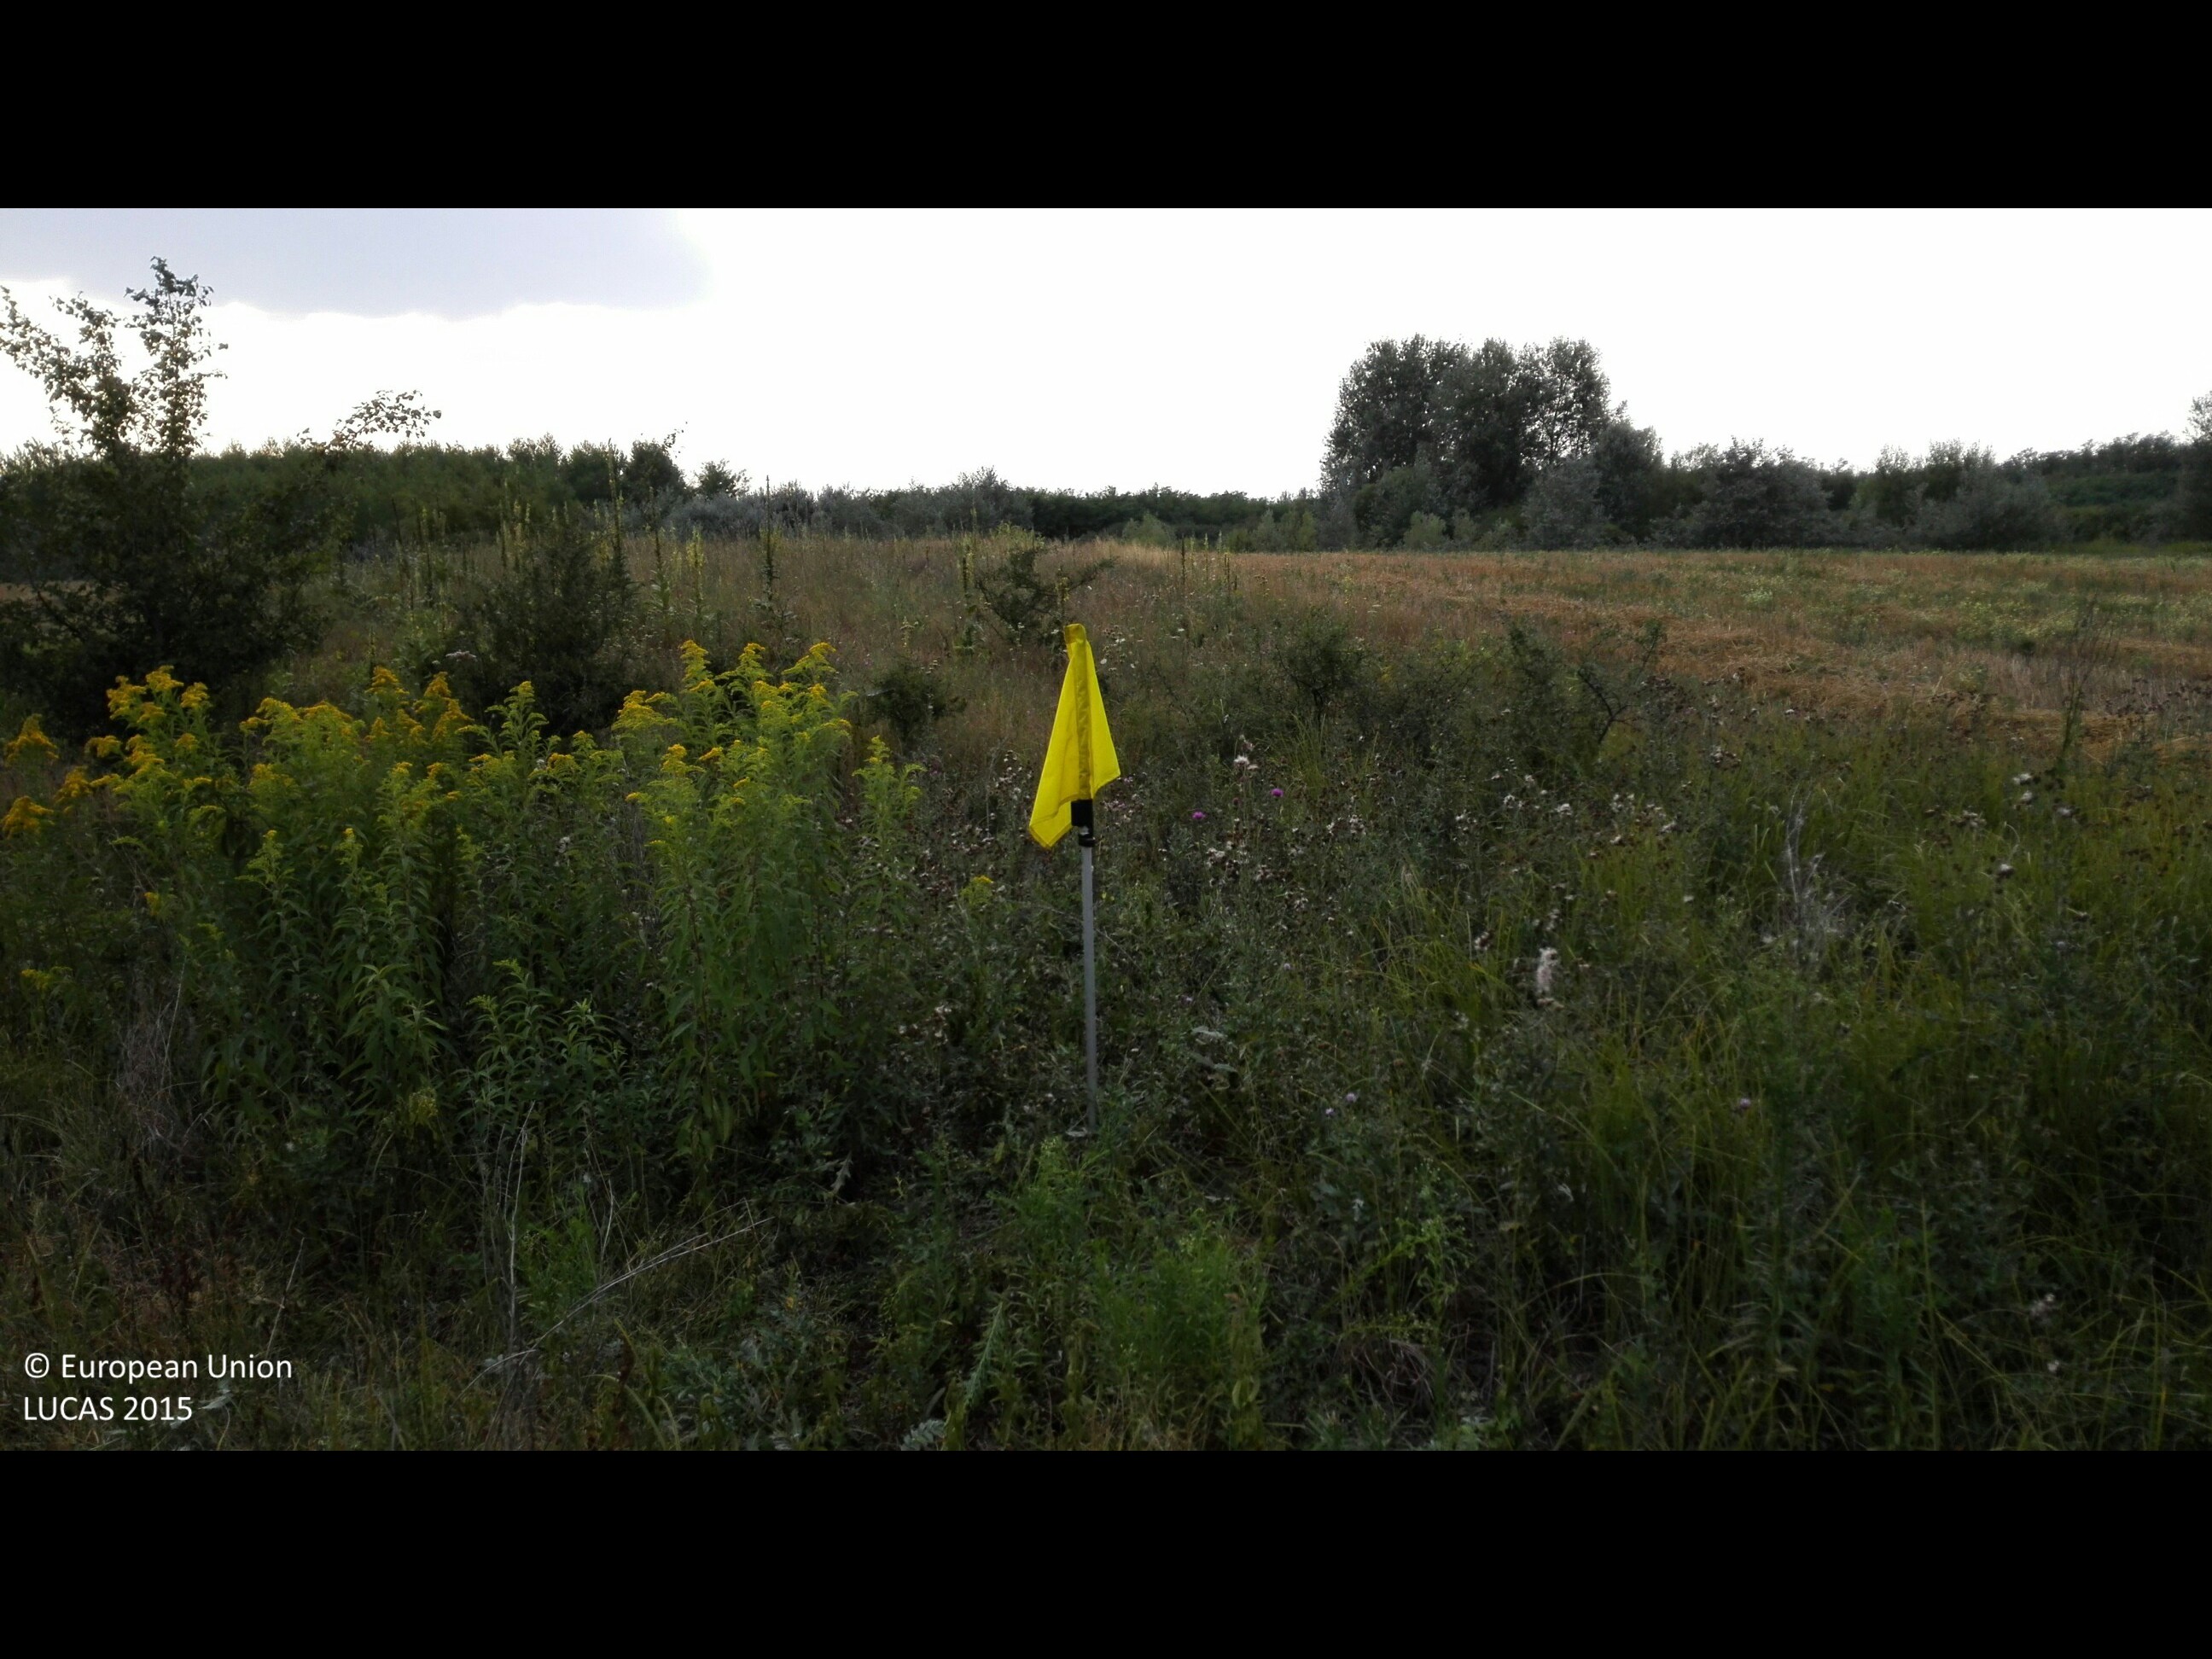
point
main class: Grassland
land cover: Spontaneously vegetated surfaces
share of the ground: > 75 %
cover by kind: herbaceous plants 100 %
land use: Fallow land
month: August
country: HU
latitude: 47.6009
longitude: 22.0075
